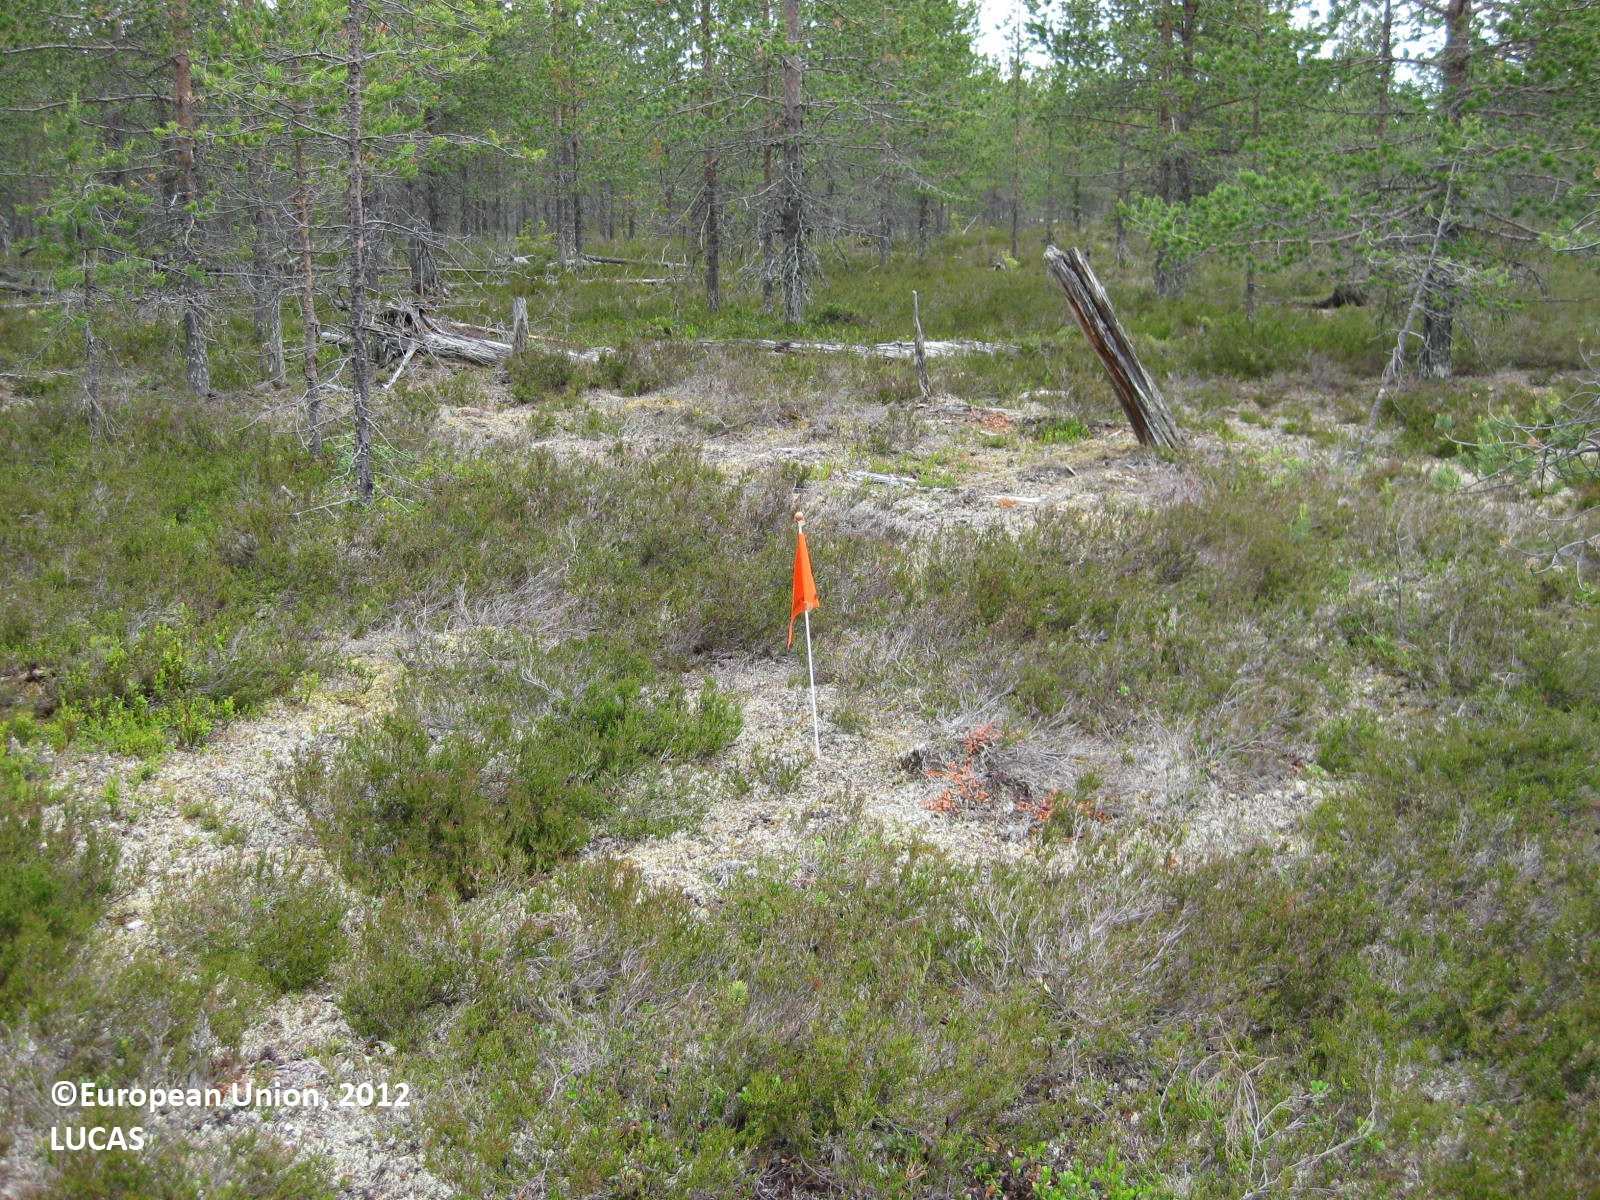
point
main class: Woodland
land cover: Pine dominated coniferous woodland
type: boreal forest
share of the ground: 25 - 50 %
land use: Forestry
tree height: > 5 m
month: July
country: FI
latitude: 65.5988
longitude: 29.2558
